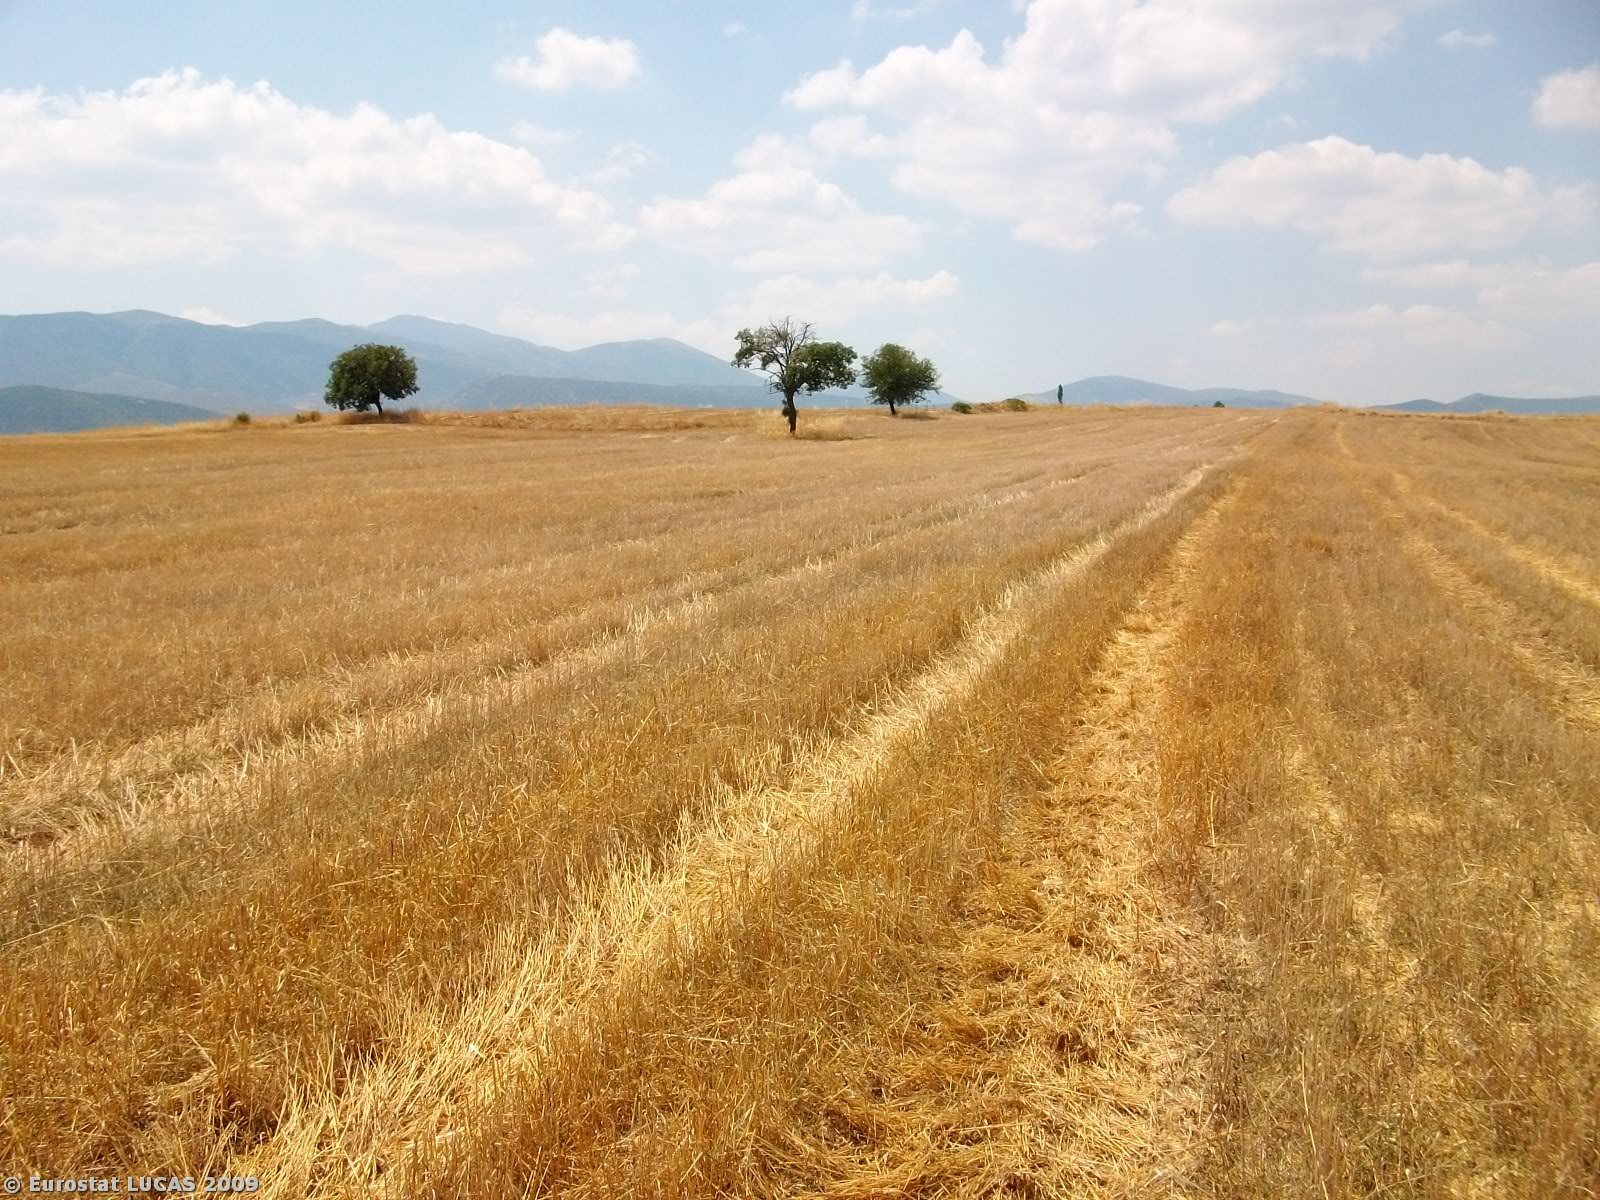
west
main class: Cropland
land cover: Durum wheat
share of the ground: < 10 %
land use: Agriculture (excluding fallow land and kitchen gardens)
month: July
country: GR
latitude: 40.2102
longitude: 21.7991
